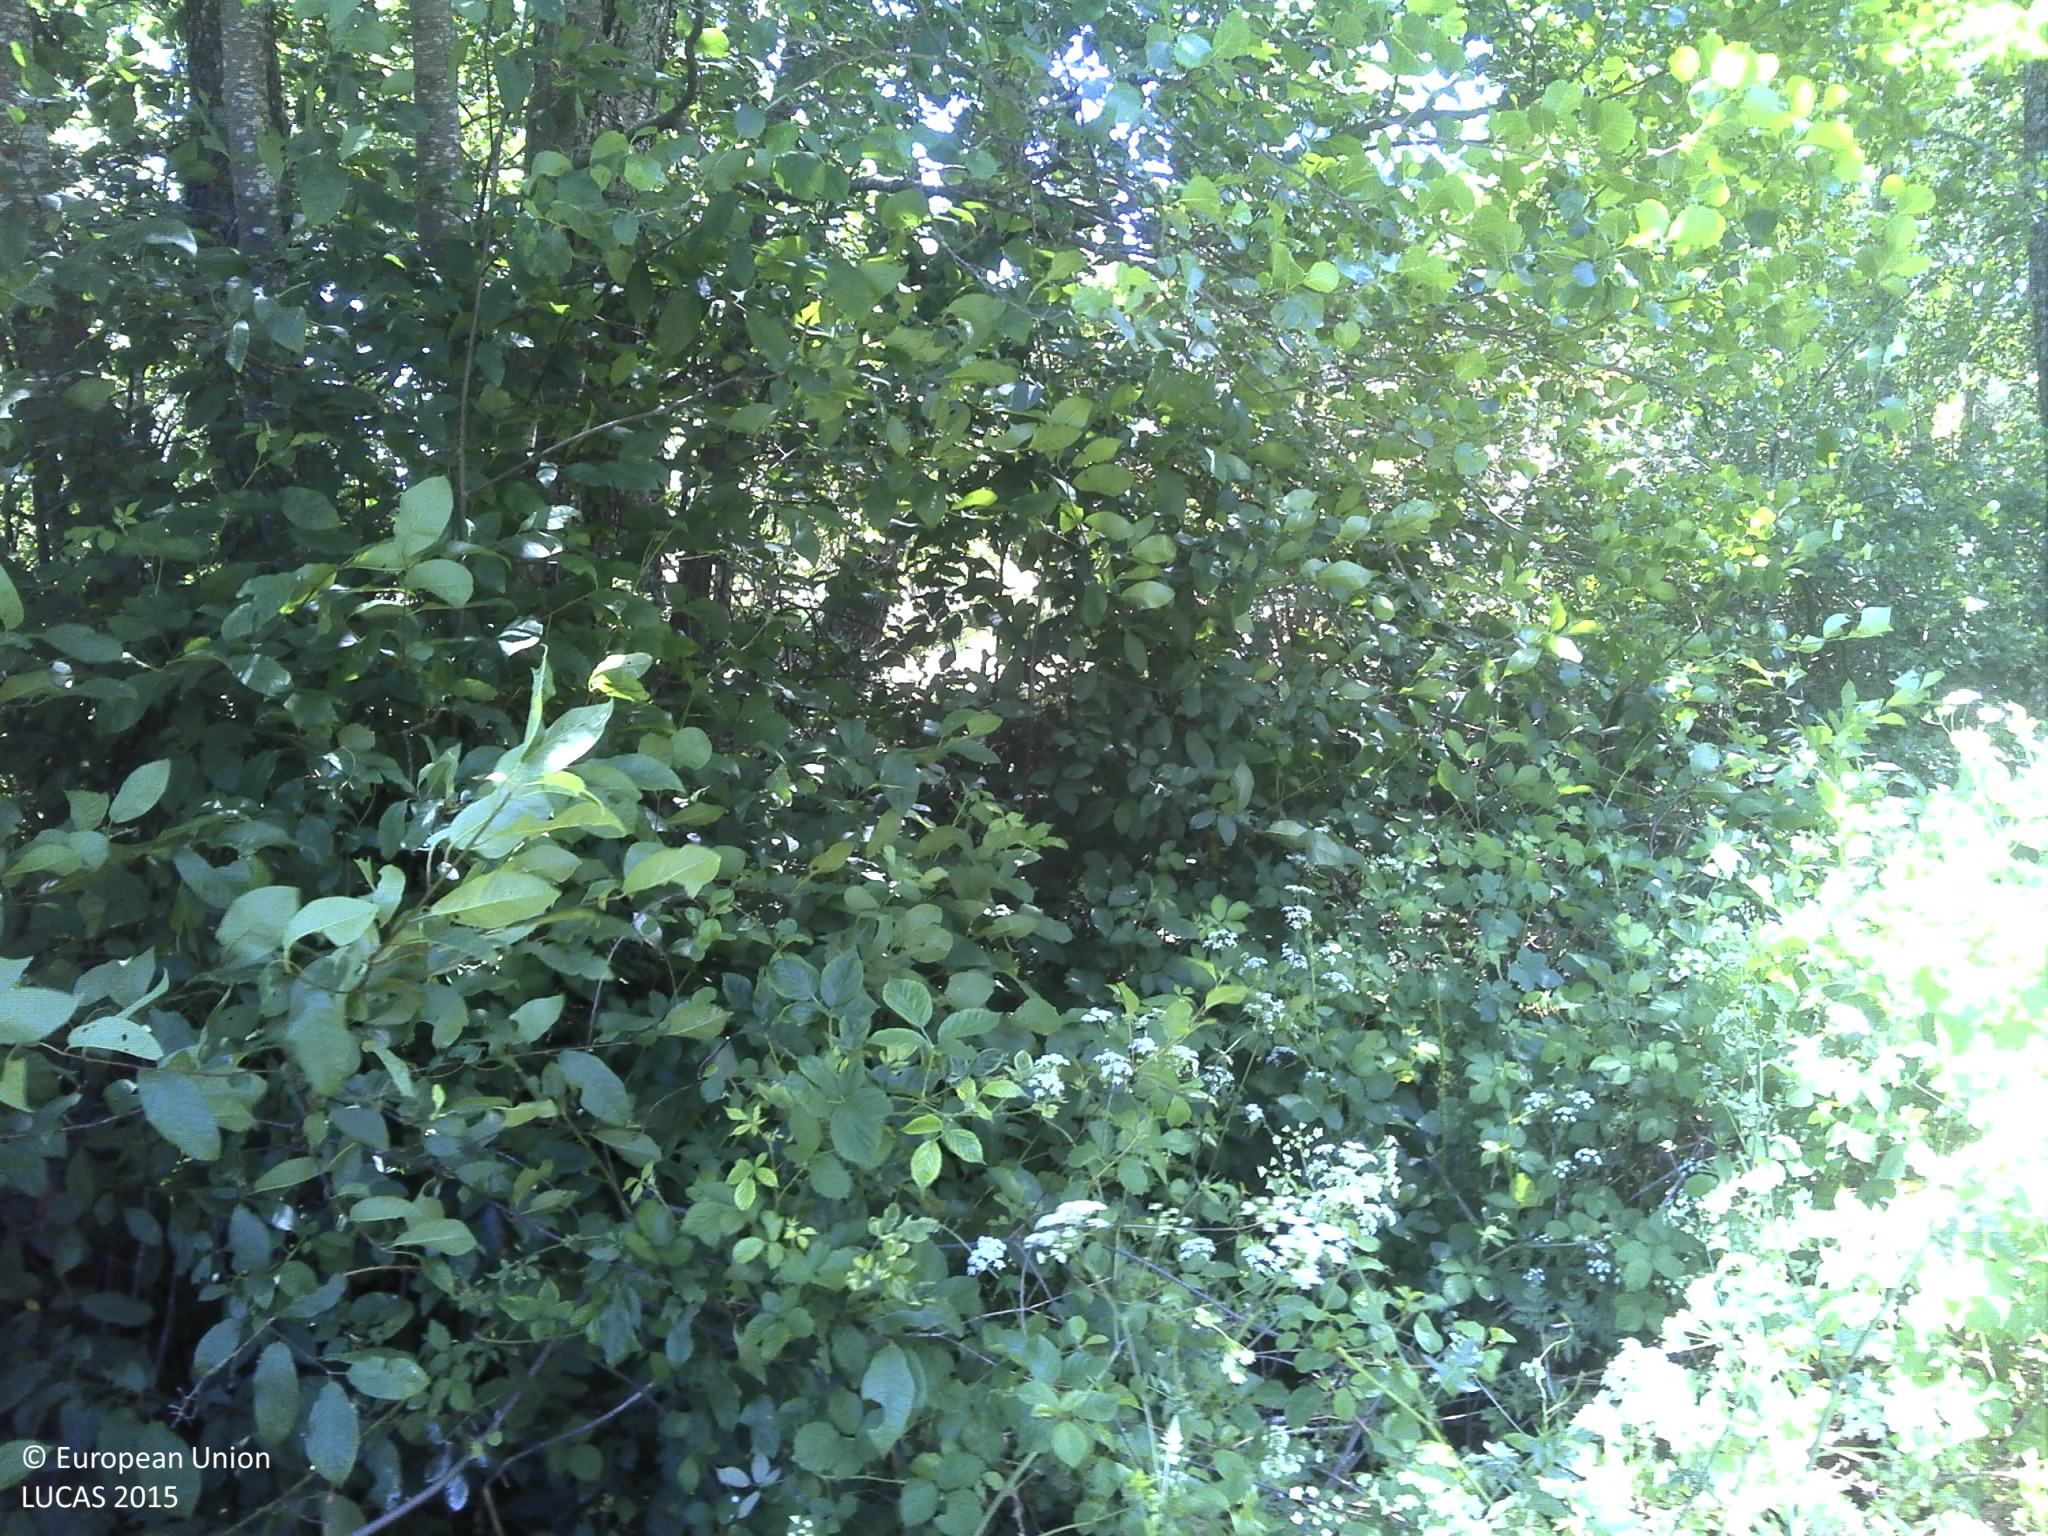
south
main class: Grassland
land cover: Grassland without tree/shrub cover
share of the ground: 50 - 75 %
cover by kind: herbaceous plants 65 %, consolidated bare surface 15 %, unconsolidated bare surface 15 %
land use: Agriculture (excluding fallow land and kitchen gardens)
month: May
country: PT
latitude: 40.5149
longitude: -7.2540
